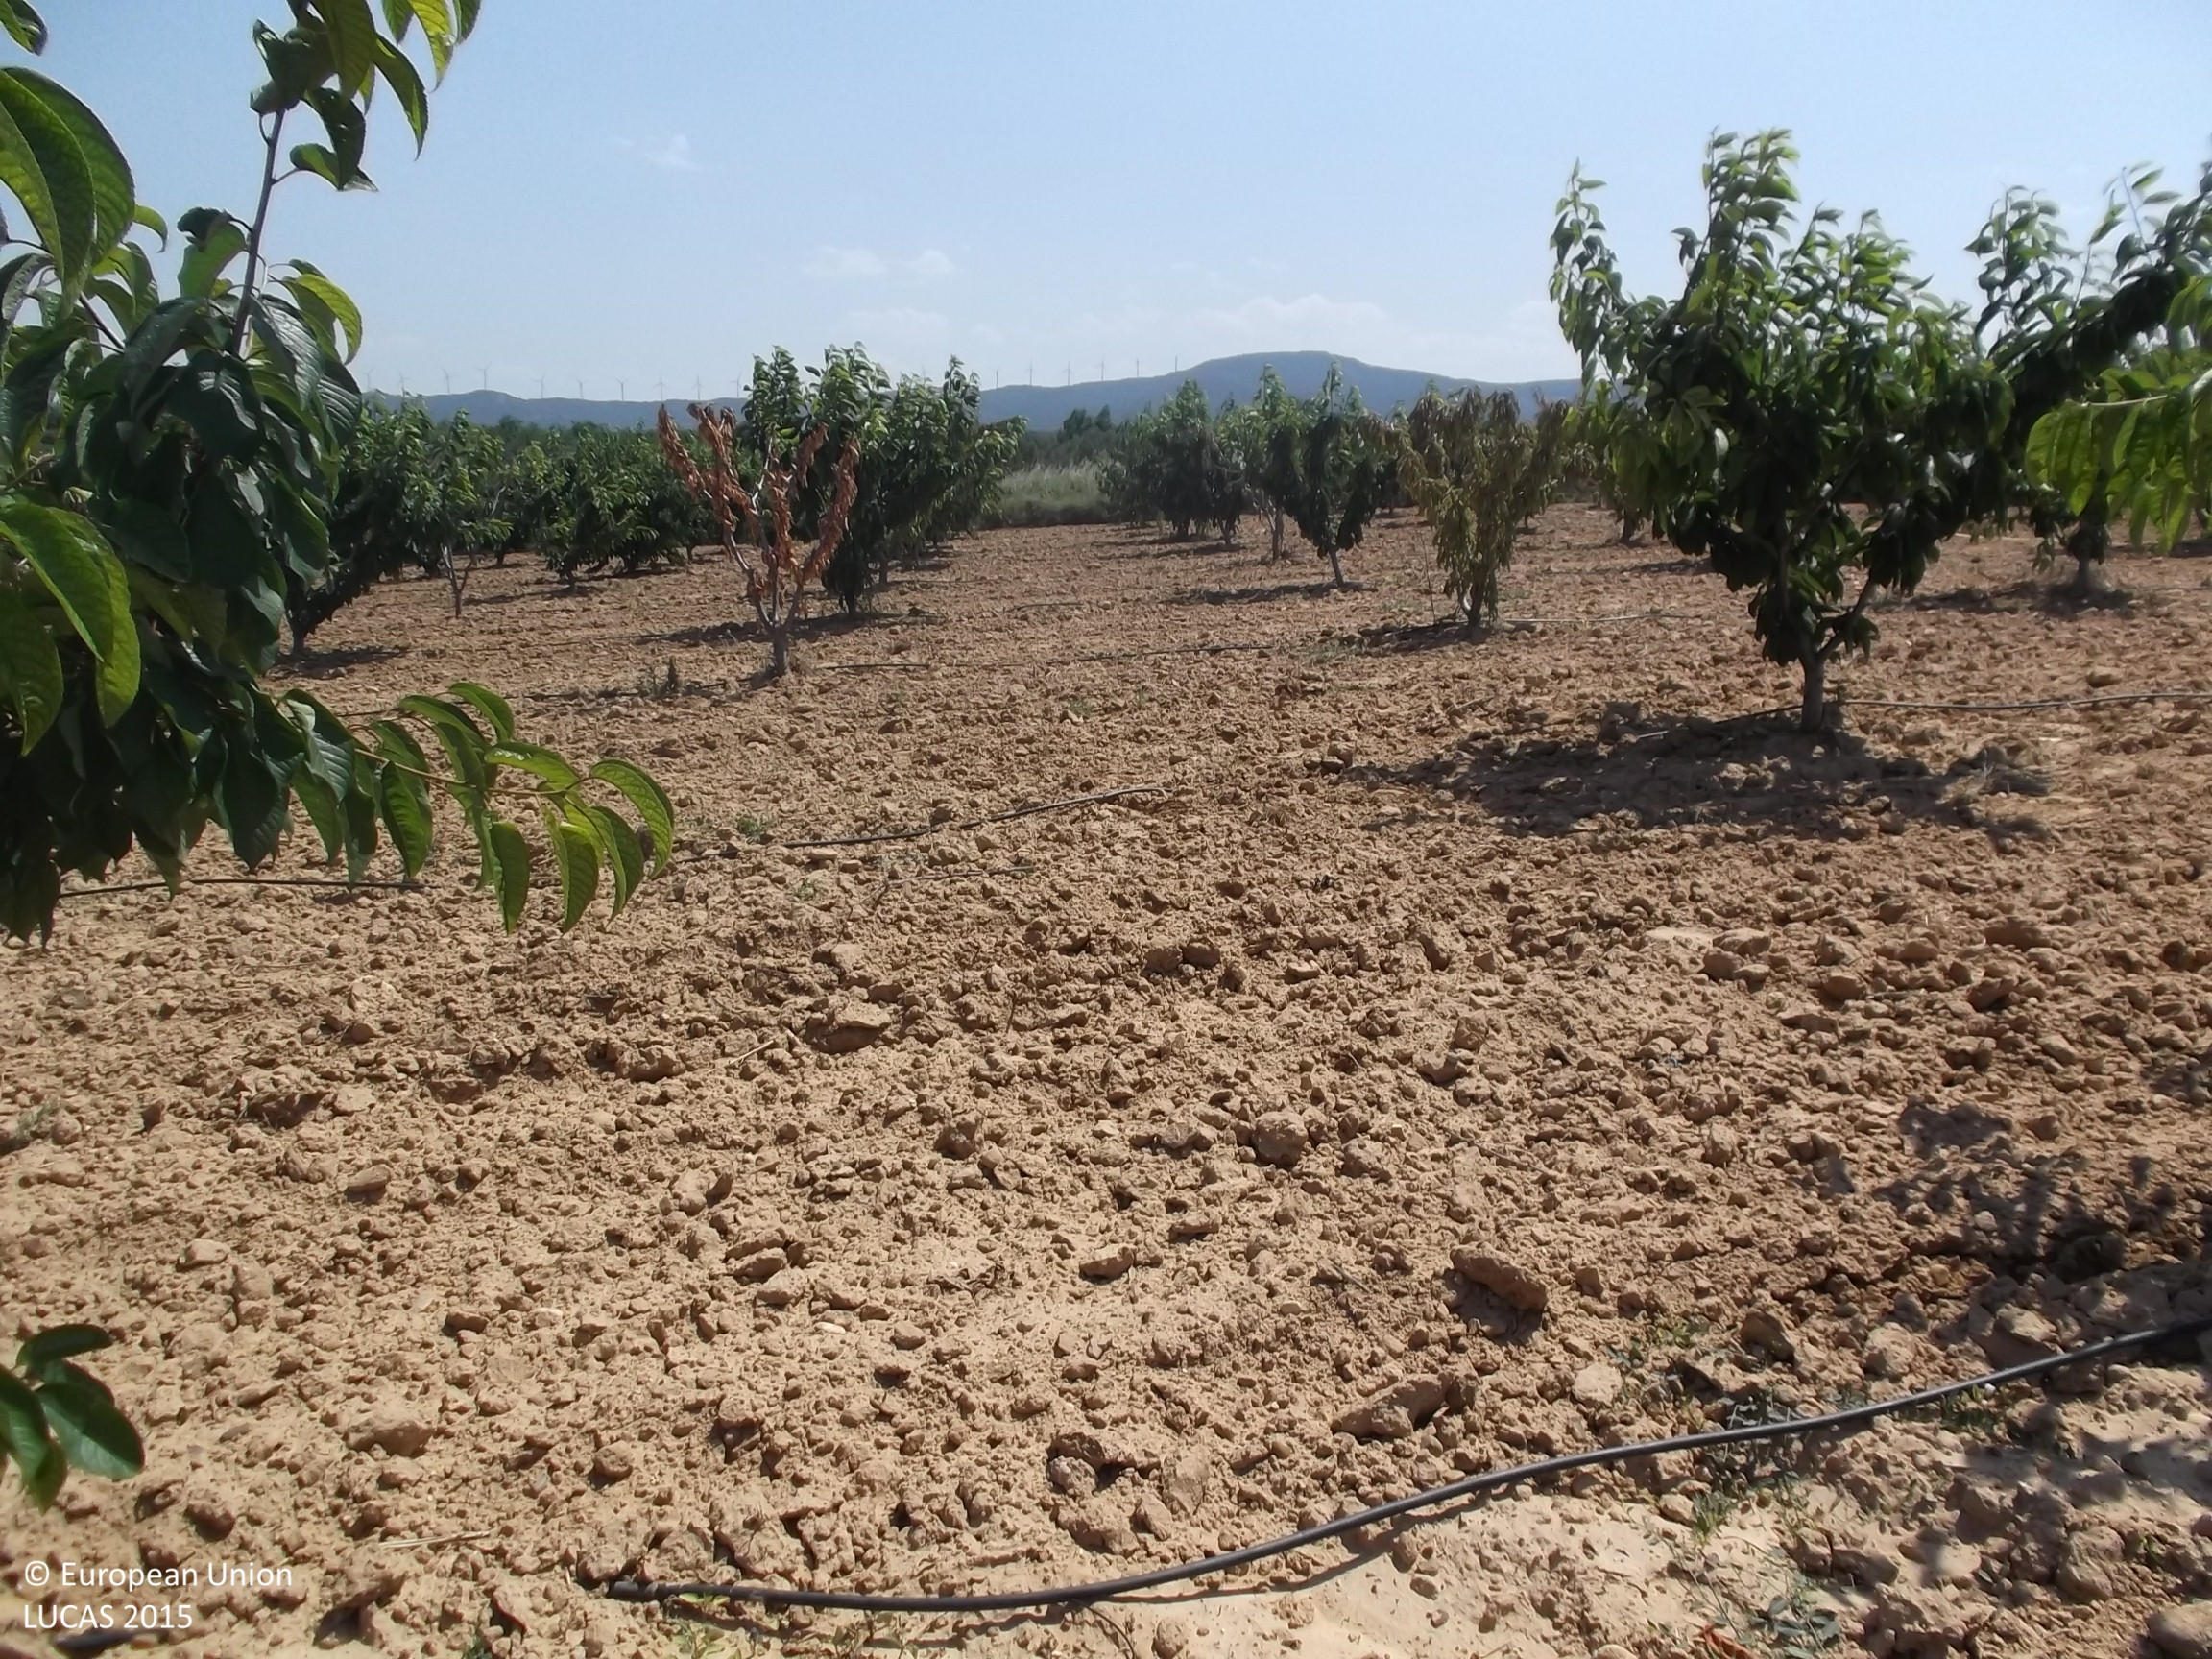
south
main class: Cropland
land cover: Cherry fruit
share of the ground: 10 - 25 %
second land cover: Other bare soil
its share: > 75 %
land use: Agriculture (excluding fallow land and kitchen gardens)
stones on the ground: < 10 %
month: June
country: ES
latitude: 42.2037
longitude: -2.0646
